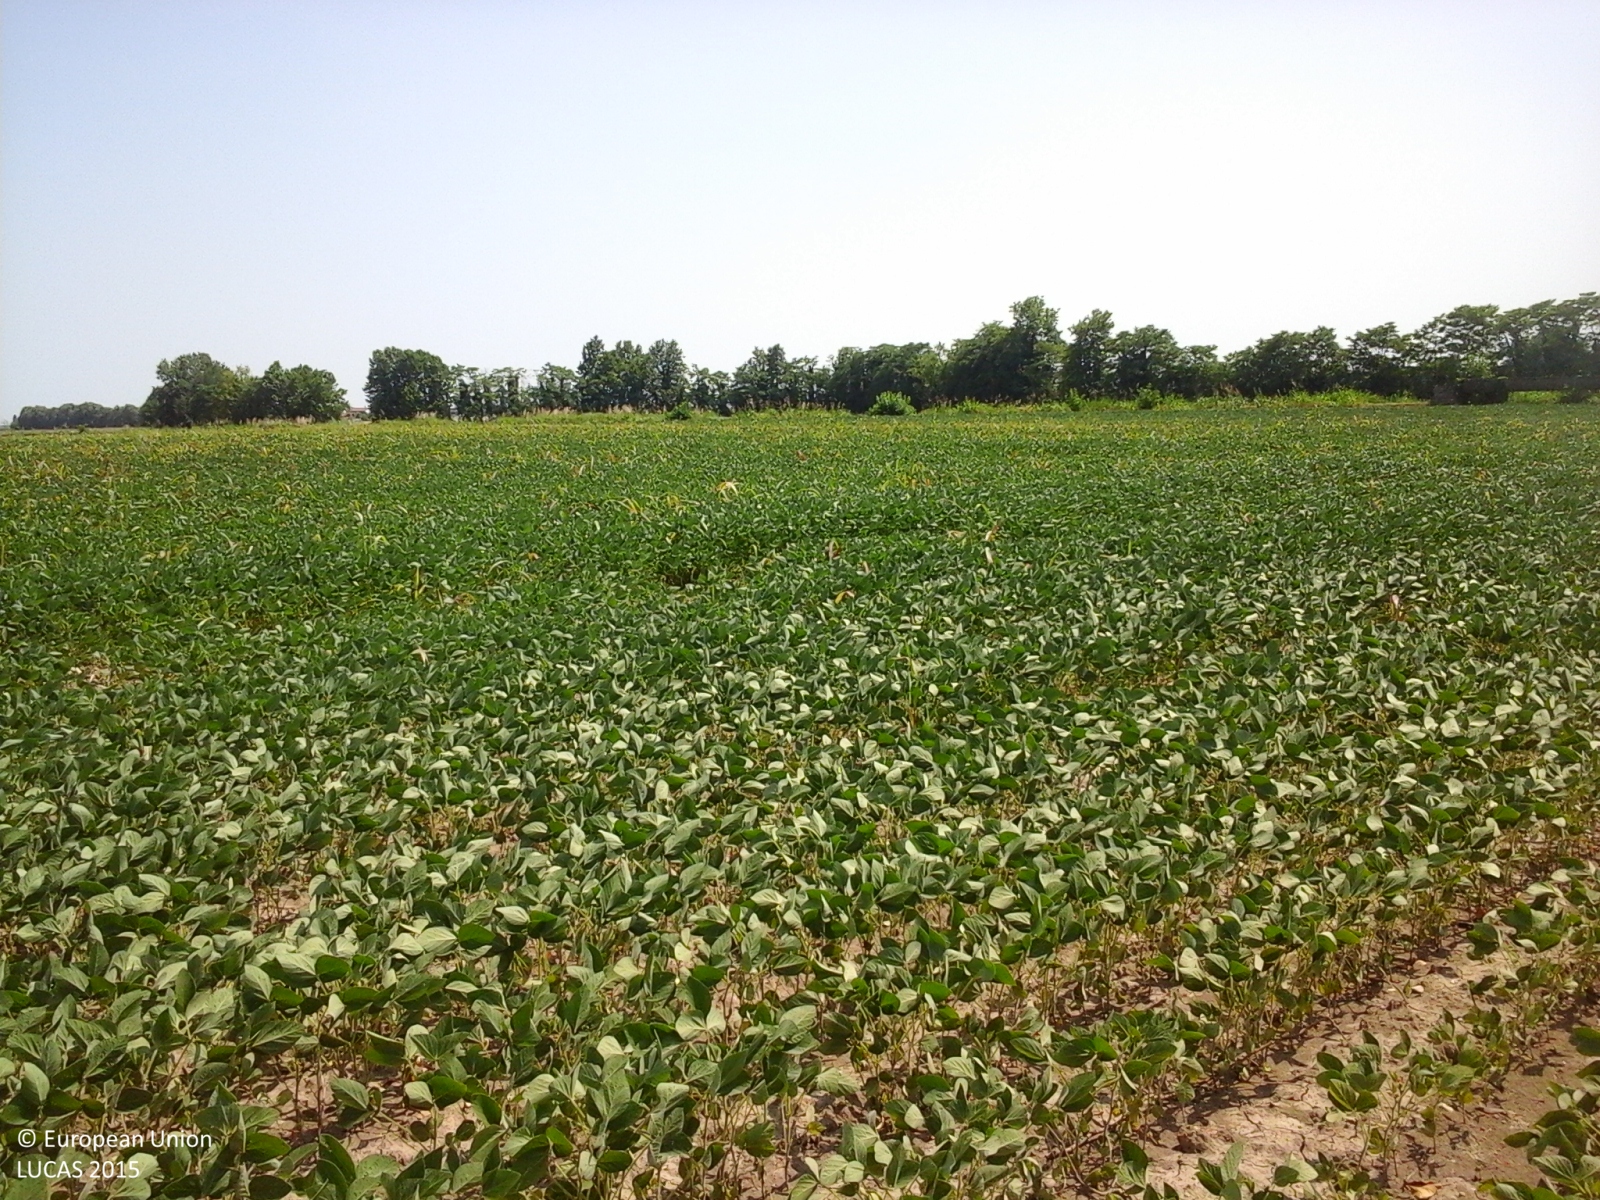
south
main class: Cropland
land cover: Barley
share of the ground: > 75 %
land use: Agriculture (excluding fallow land and kitchen gardens)
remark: Harvested field
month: July
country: IT
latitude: 45.3383
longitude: 10.9044
